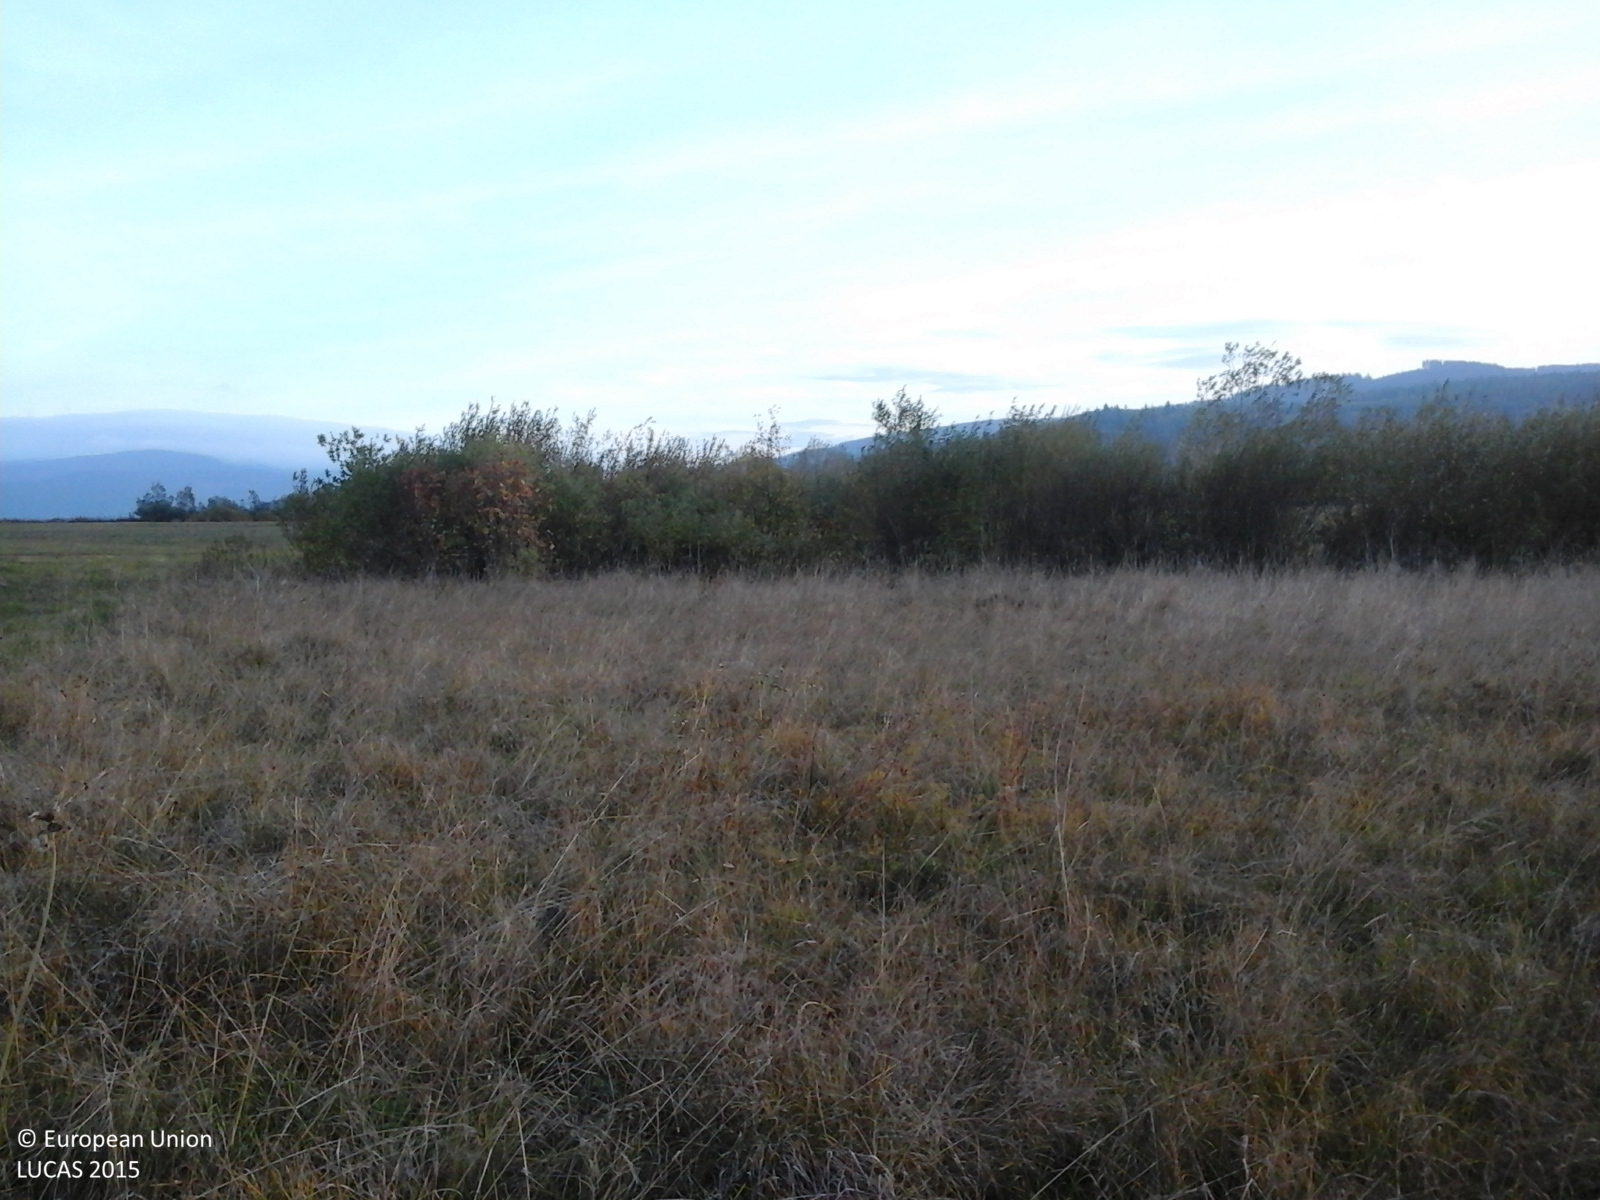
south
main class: Grassland
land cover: Grassland without tree/shrub cover
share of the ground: > 75 %
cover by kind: herbaceous plants 100 %
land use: Agriculture (excluding fallow land and kitchen gardens)
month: October
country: RO
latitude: 46.6541
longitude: 25.5434
